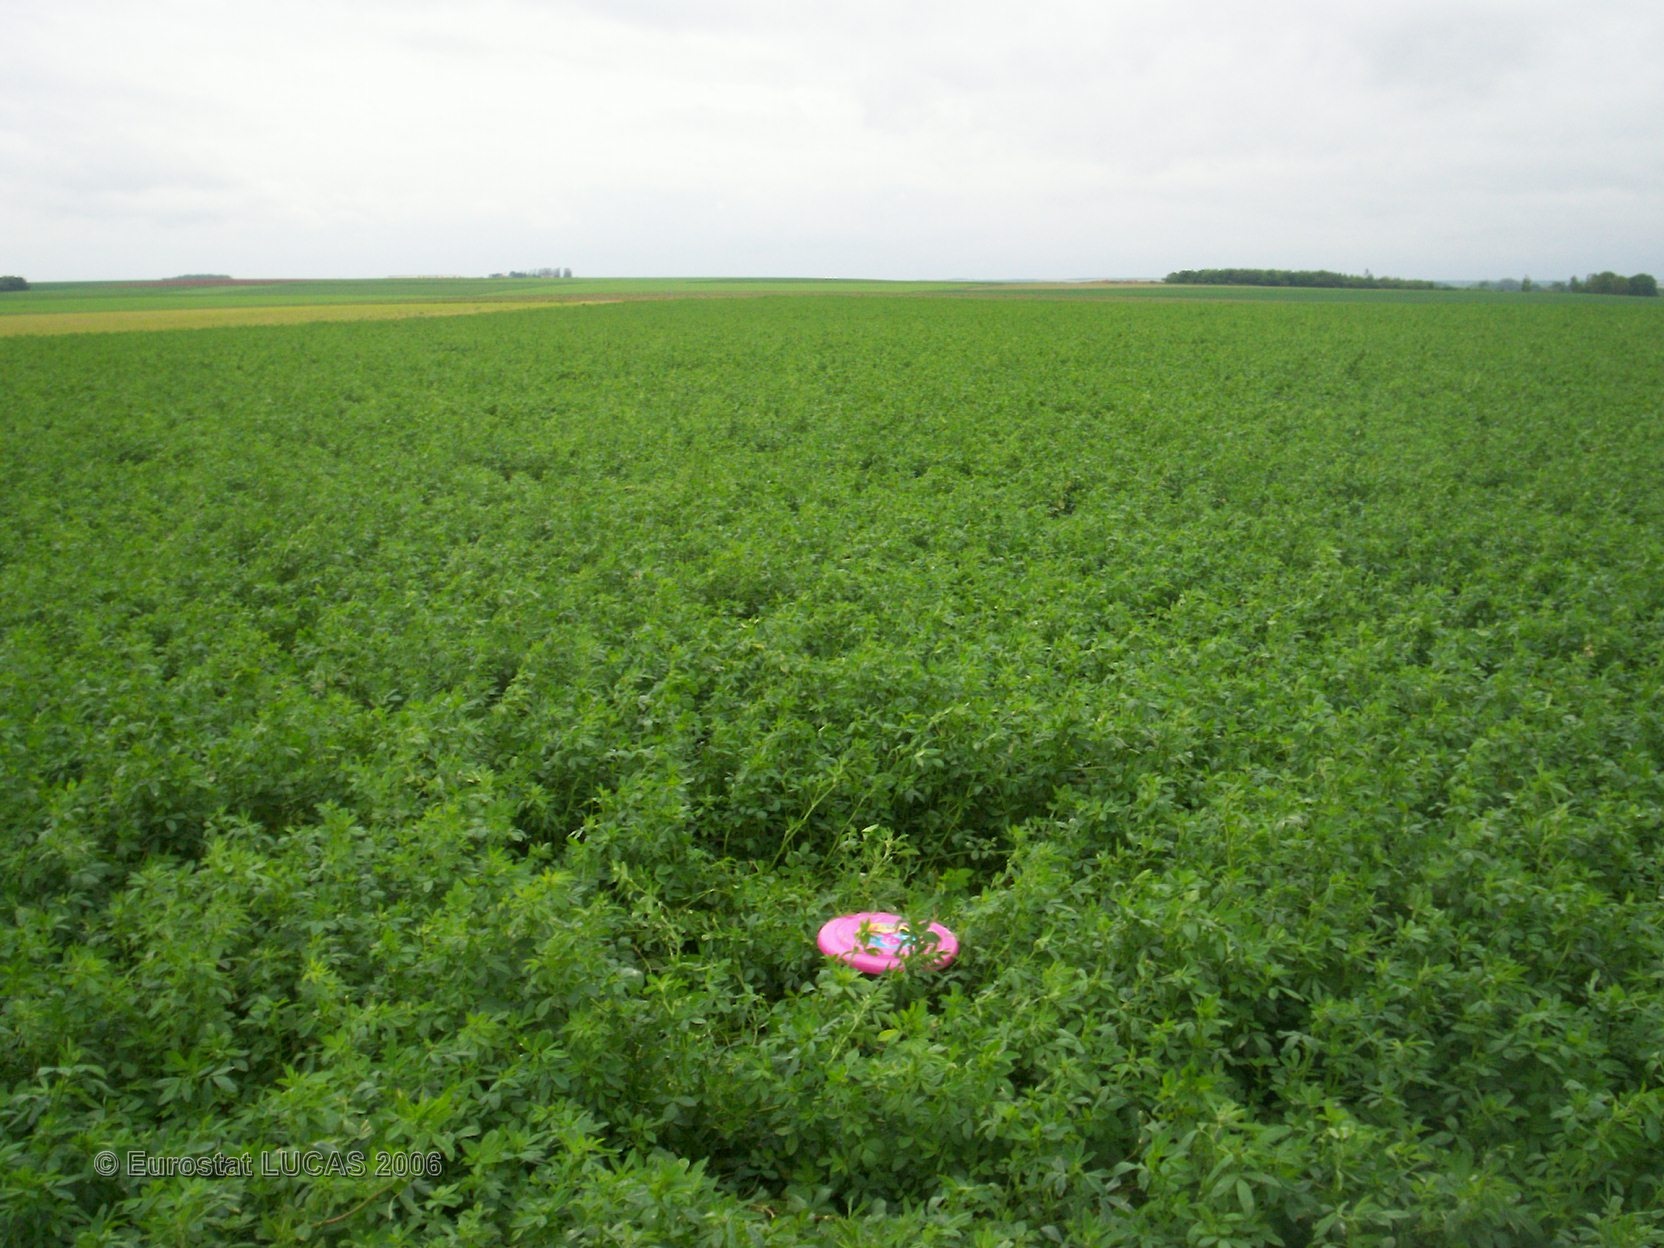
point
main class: Cropland
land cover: Lucerne
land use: Agriculture (excluding fallow land and kitchen gardens)
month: May
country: FR
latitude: 49.3943
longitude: 4.3330
